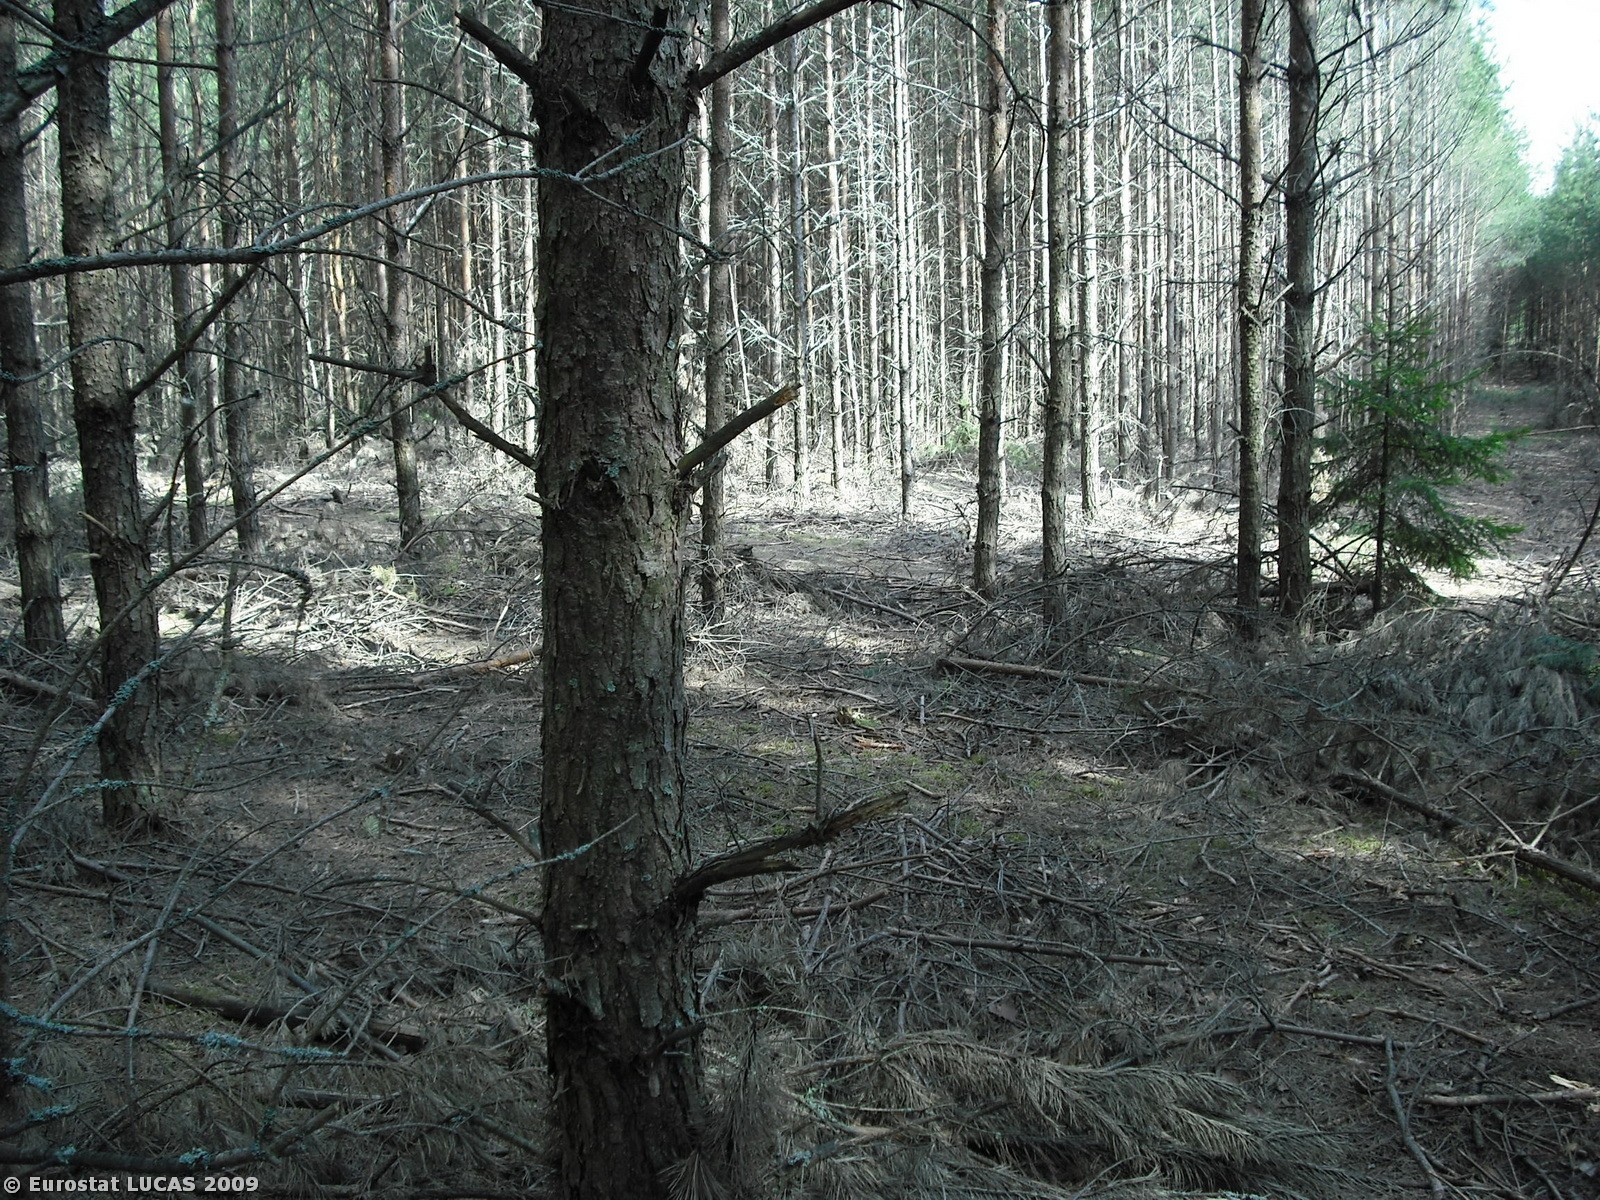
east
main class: Woodland
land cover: Coniferous woodland
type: hemiboreal forest and nemoral coniferous forest and mixed broadleaved-coniferous forest
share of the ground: > 75 %
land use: Forestry
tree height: > 5 m
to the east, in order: Coniferous woodland; Tracks; Coniferous woodland; Tracks; Coniferous woodland; Tracks; Coniferous woodland
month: May
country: PL
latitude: 53.0687
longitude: 23.5923
